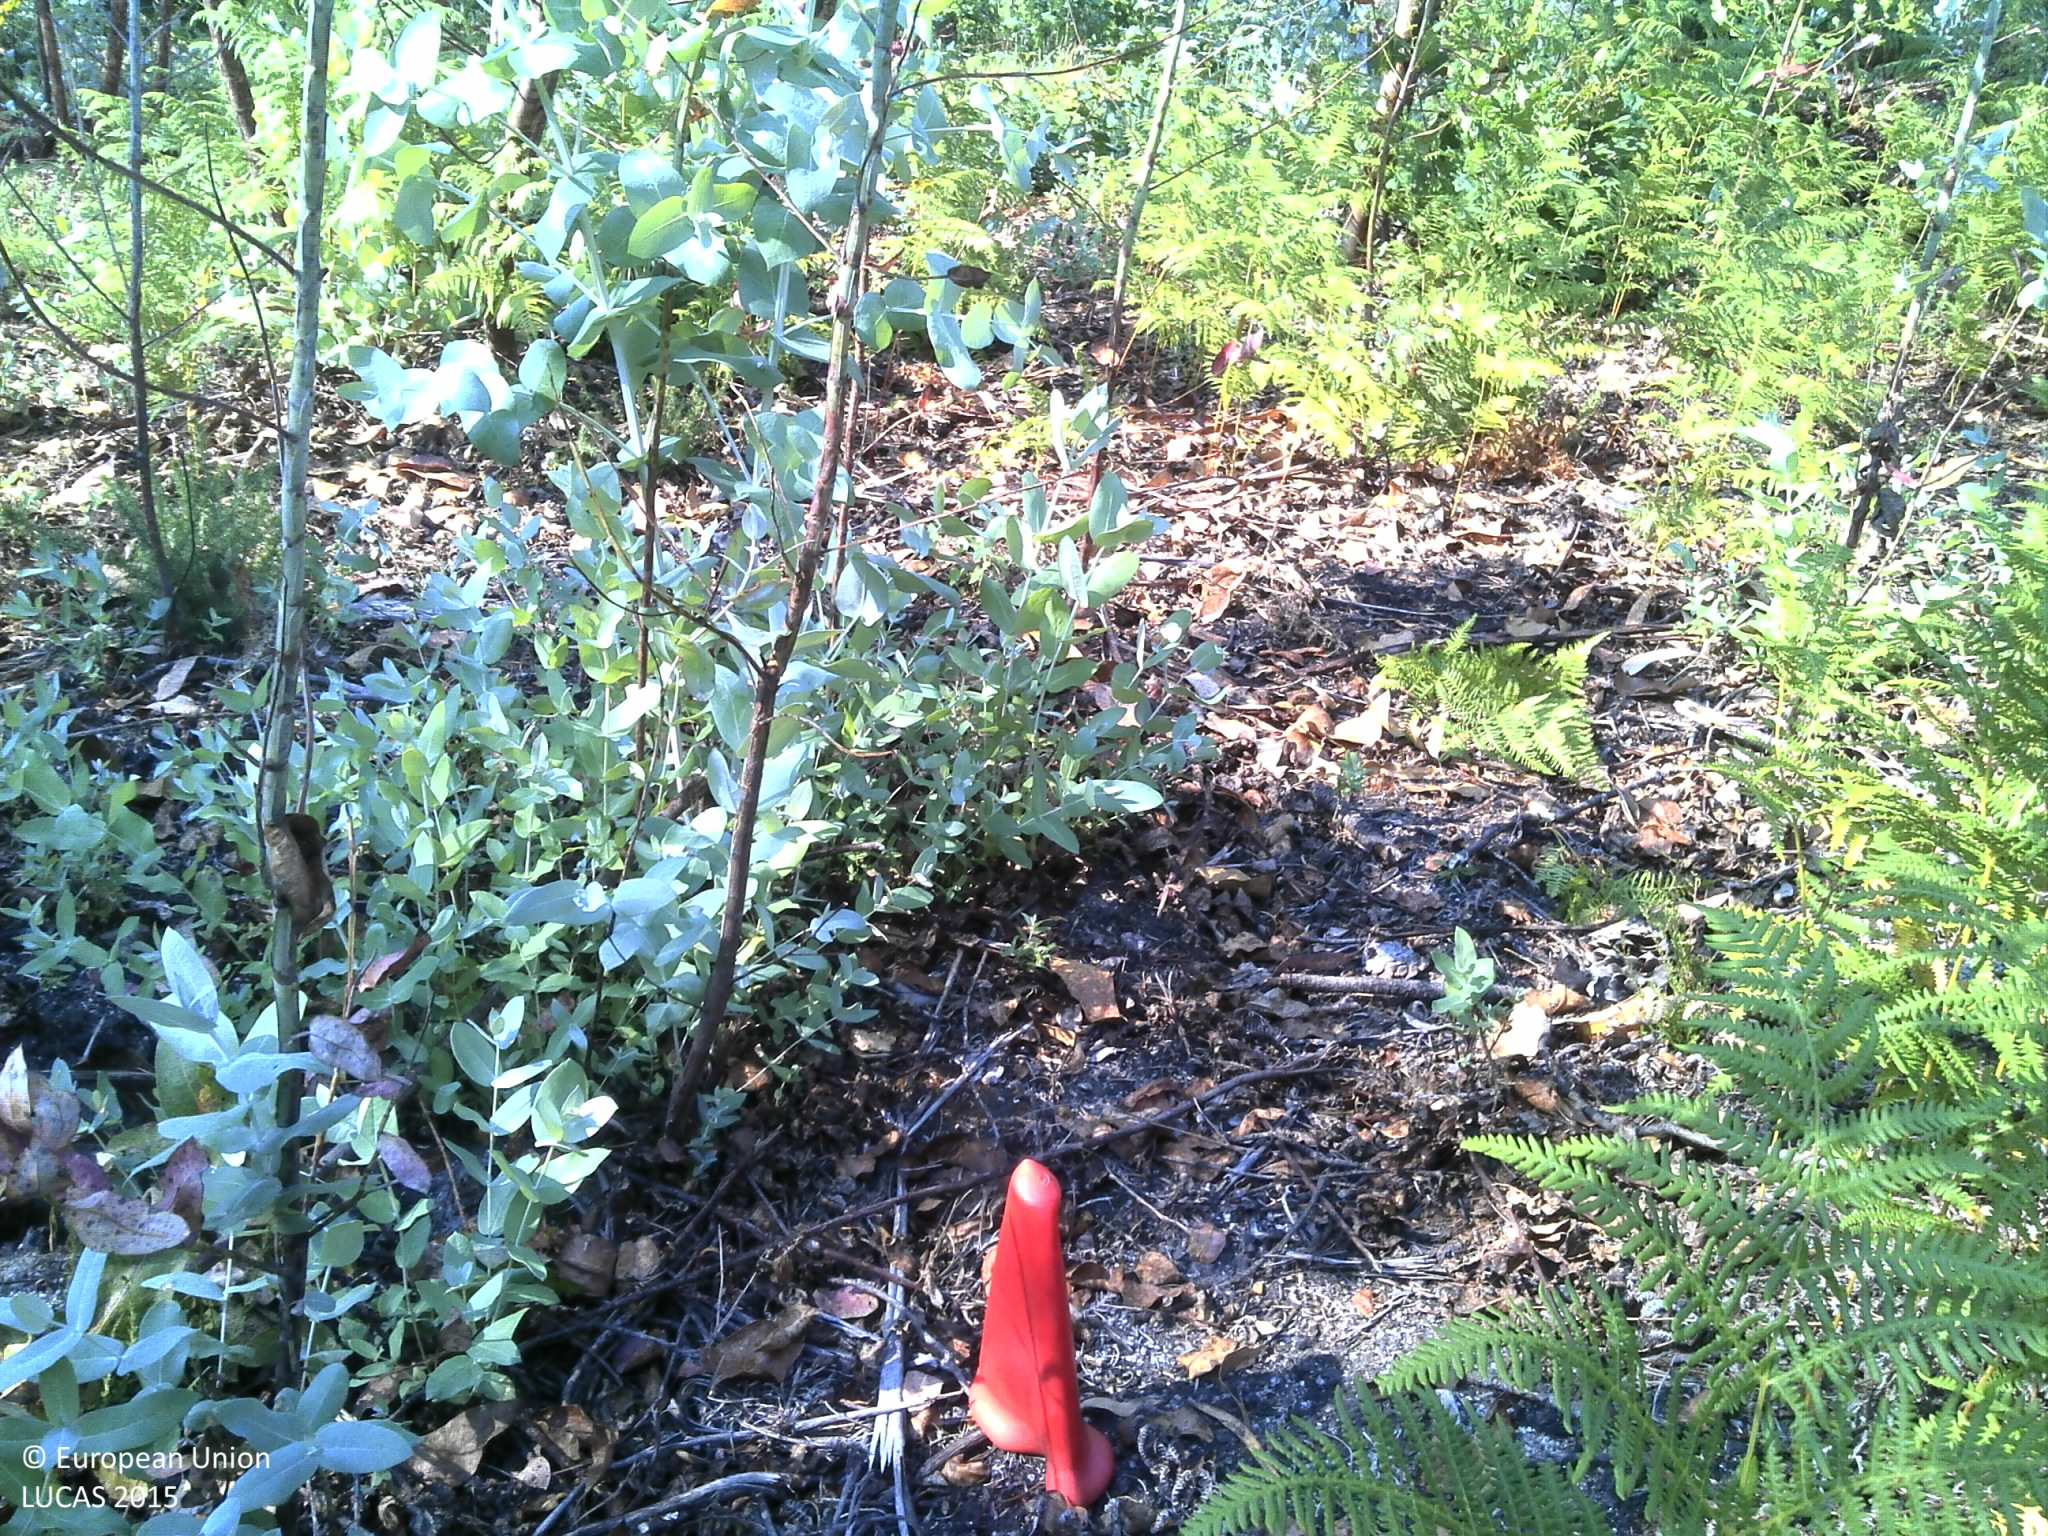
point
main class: Woodland
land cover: Broadleaved woodland
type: exotic forest
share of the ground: 50 - 75 %
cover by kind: broadleaved forest trees 60 %, shrubs 20 %, unconsolidated bare surface 20 %
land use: Forestry
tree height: < 5 m
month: June
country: PT
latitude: 40.6221
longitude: -8.0849
